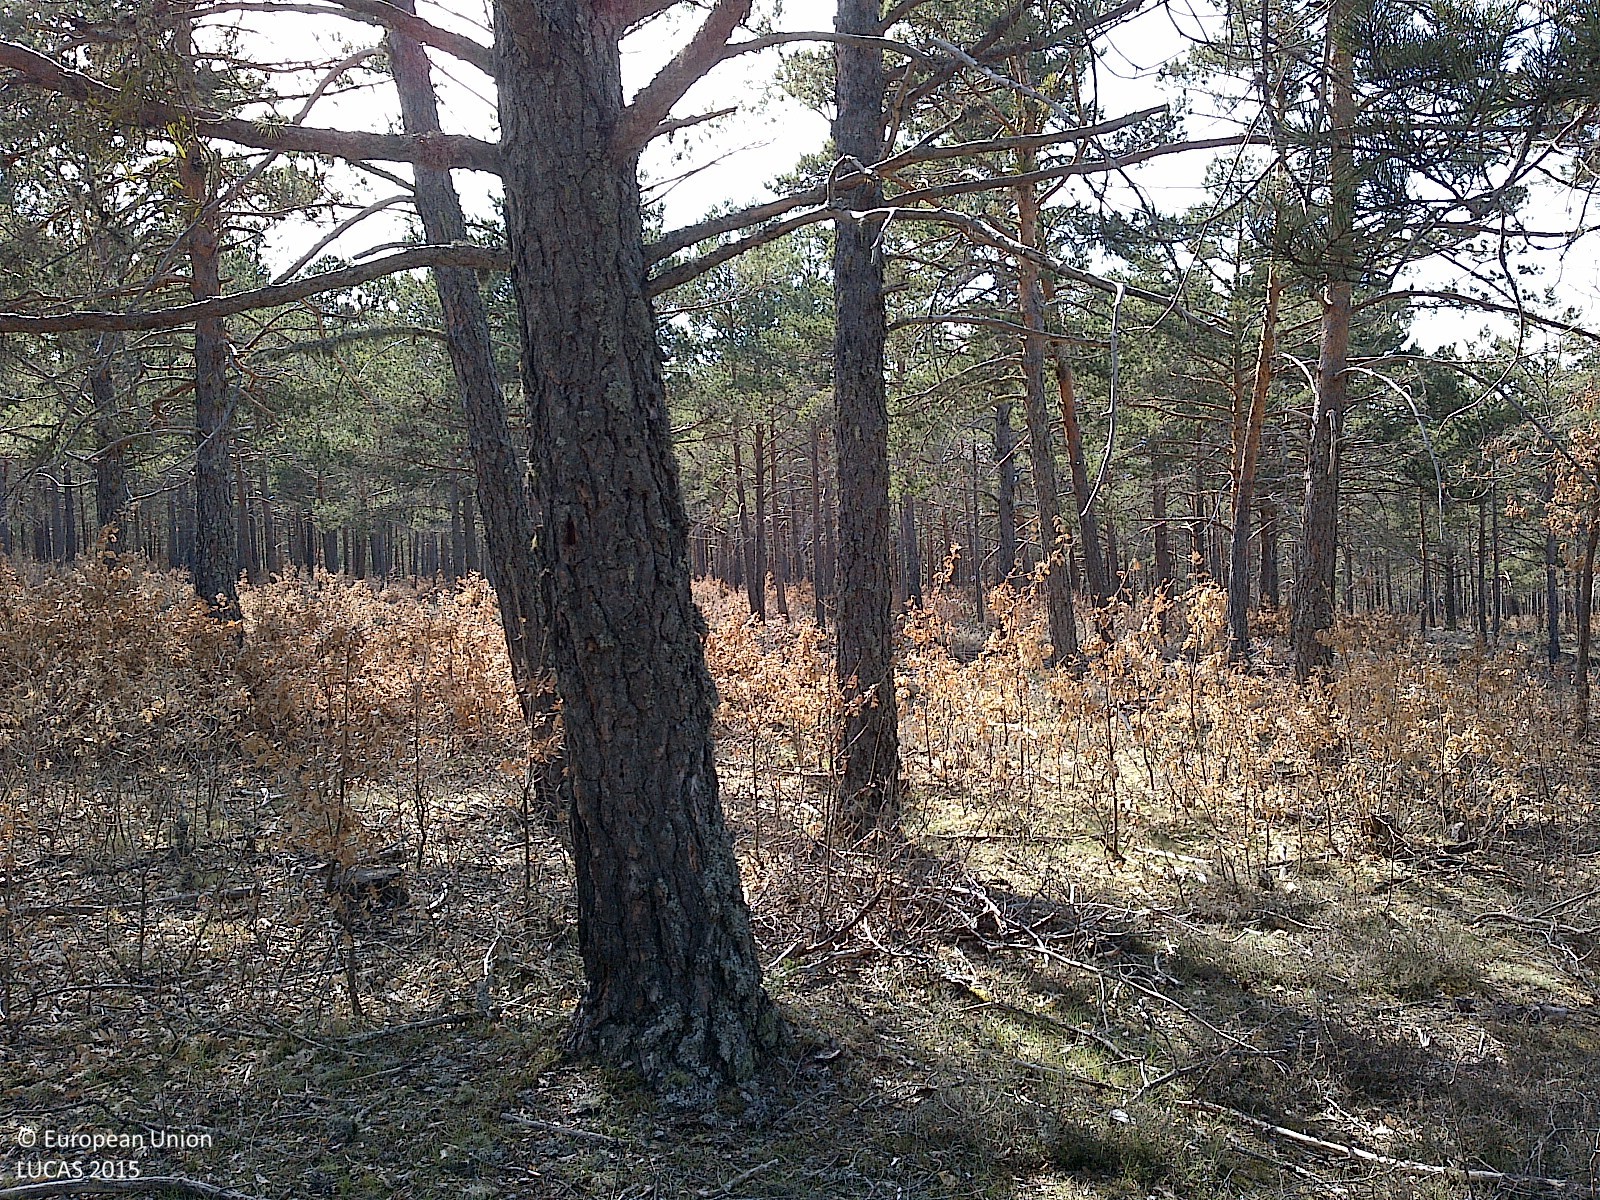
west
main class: Woodland
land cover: Pine dominated coniferous woodland
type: coniferous forest of the mediterranean region
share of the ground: > 75 %
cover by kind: coniferous forest trees 85 %, herbaceous plants 10 %, shrubs 5 %
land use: Forestry
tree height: > 5 m
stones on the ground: < 10 %
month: April
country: ES
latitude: 41.8535
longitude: -2.8231
